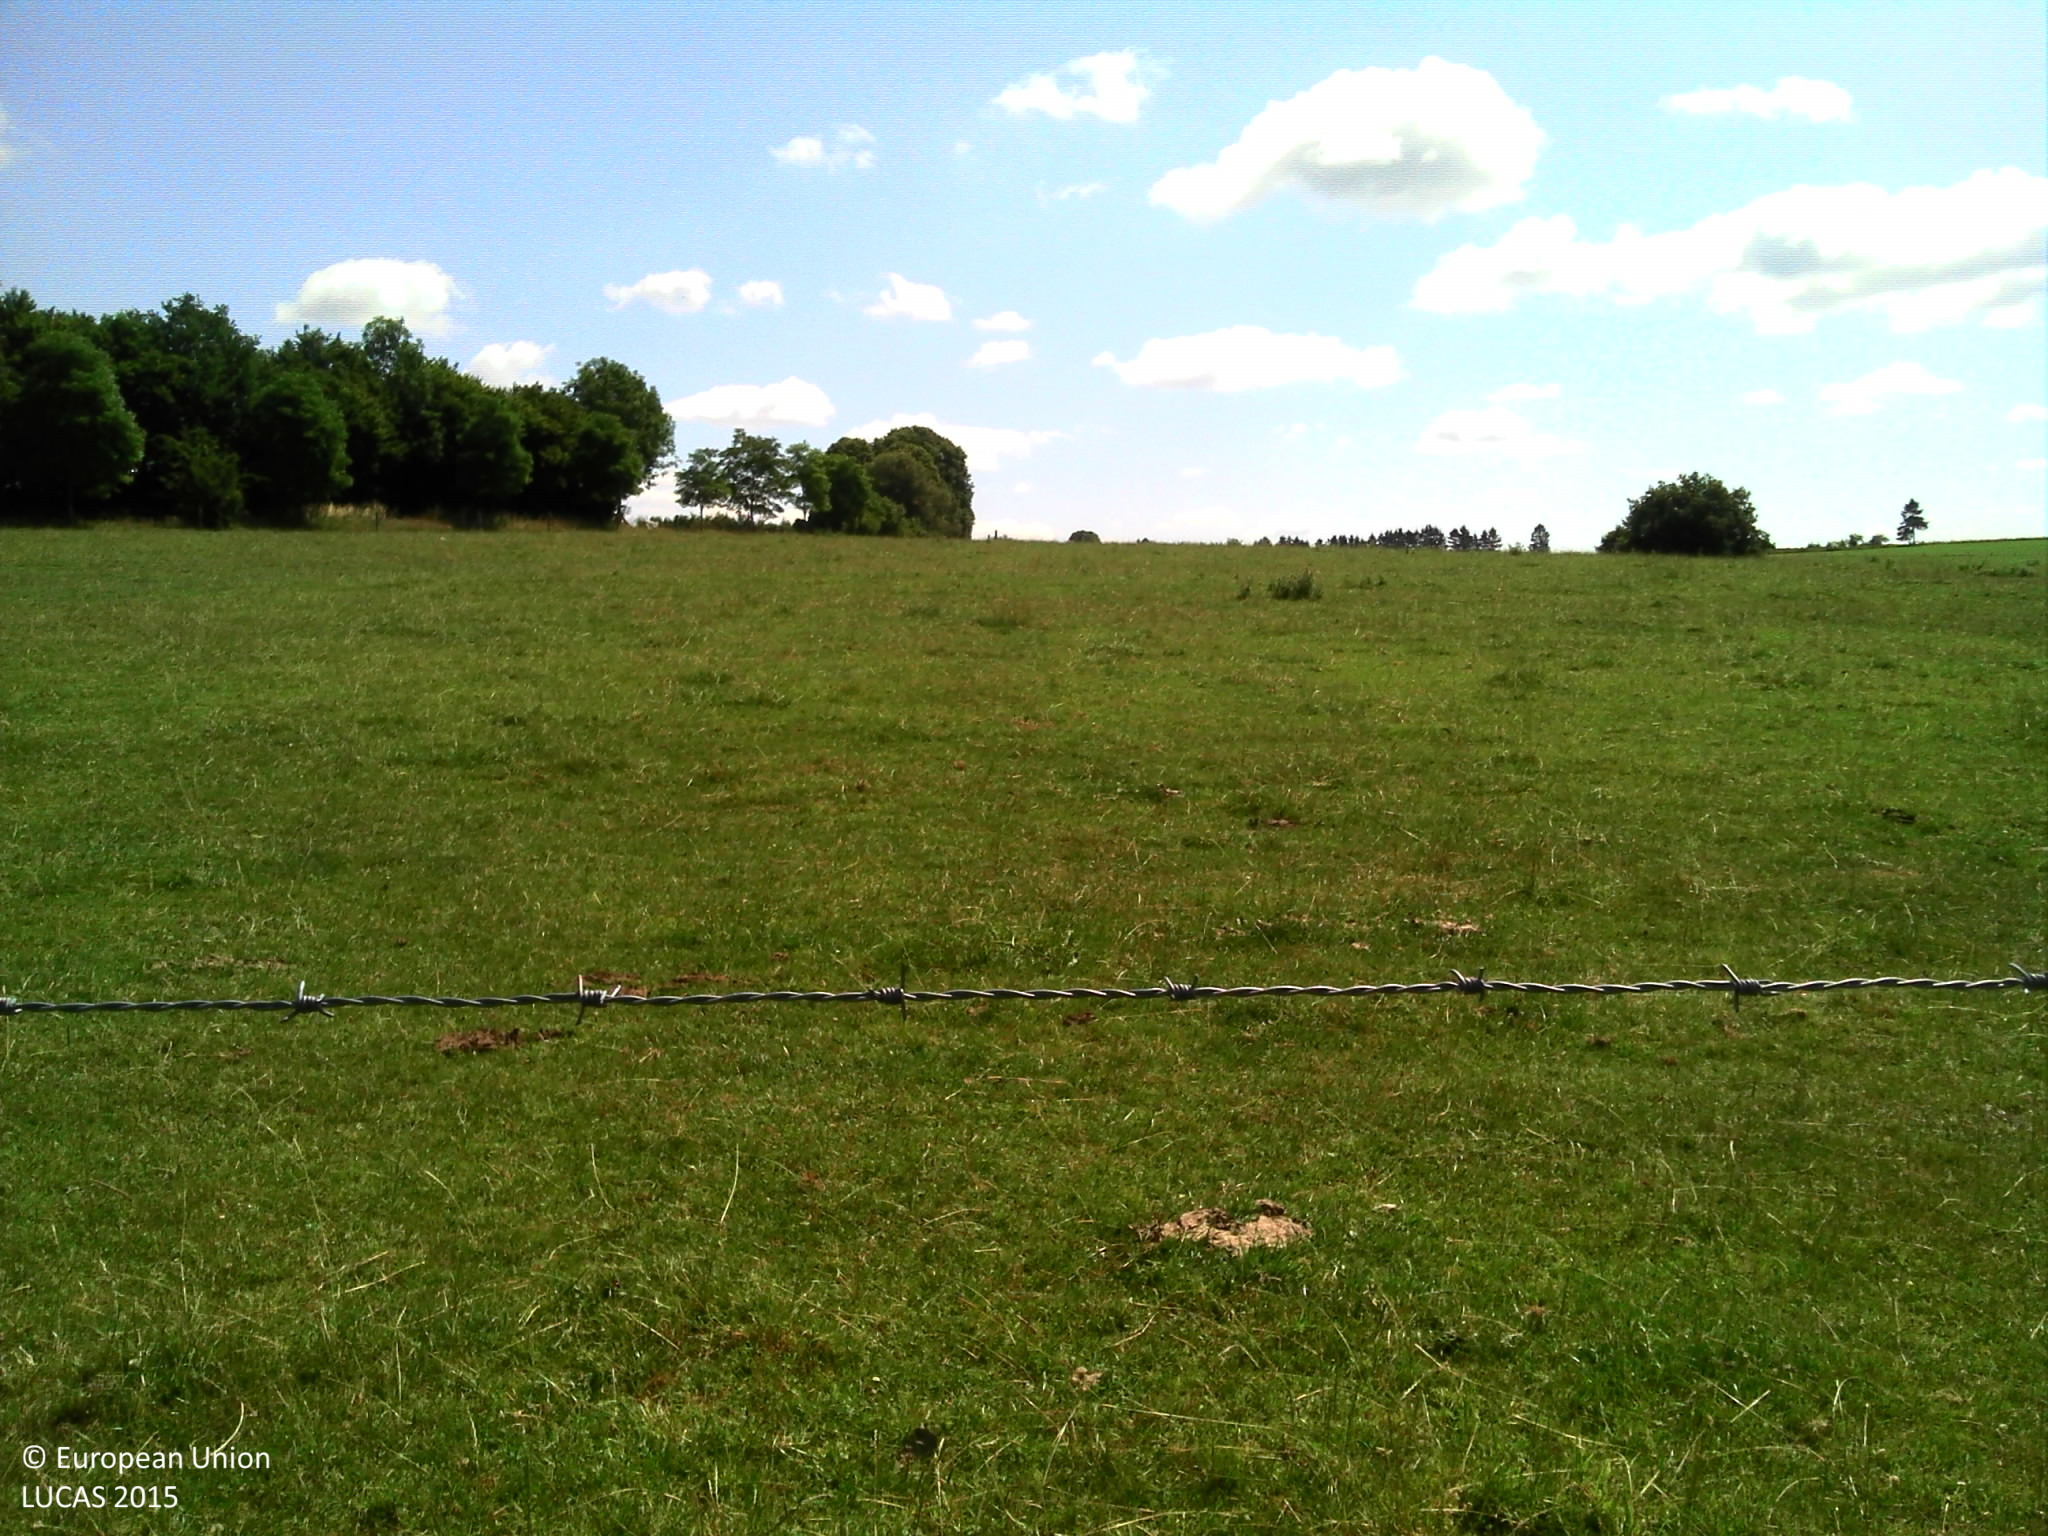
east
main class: Grassland
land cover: Grassland without tree/shrub cover
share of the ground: > 75 %
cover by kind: herbaceous plants 100 %
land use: Agriculture (excluding fallow land and kitchen gardens)
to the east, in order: Grassland without tree/shrub cover; Fences; Grass margins; Lines of trees; Grass margins; Paved roads, cycling and walking lanes; Grass margins; Single bushes/trees; Grass margins
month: July
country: BE
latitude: 50.0158
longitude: 5.7702
